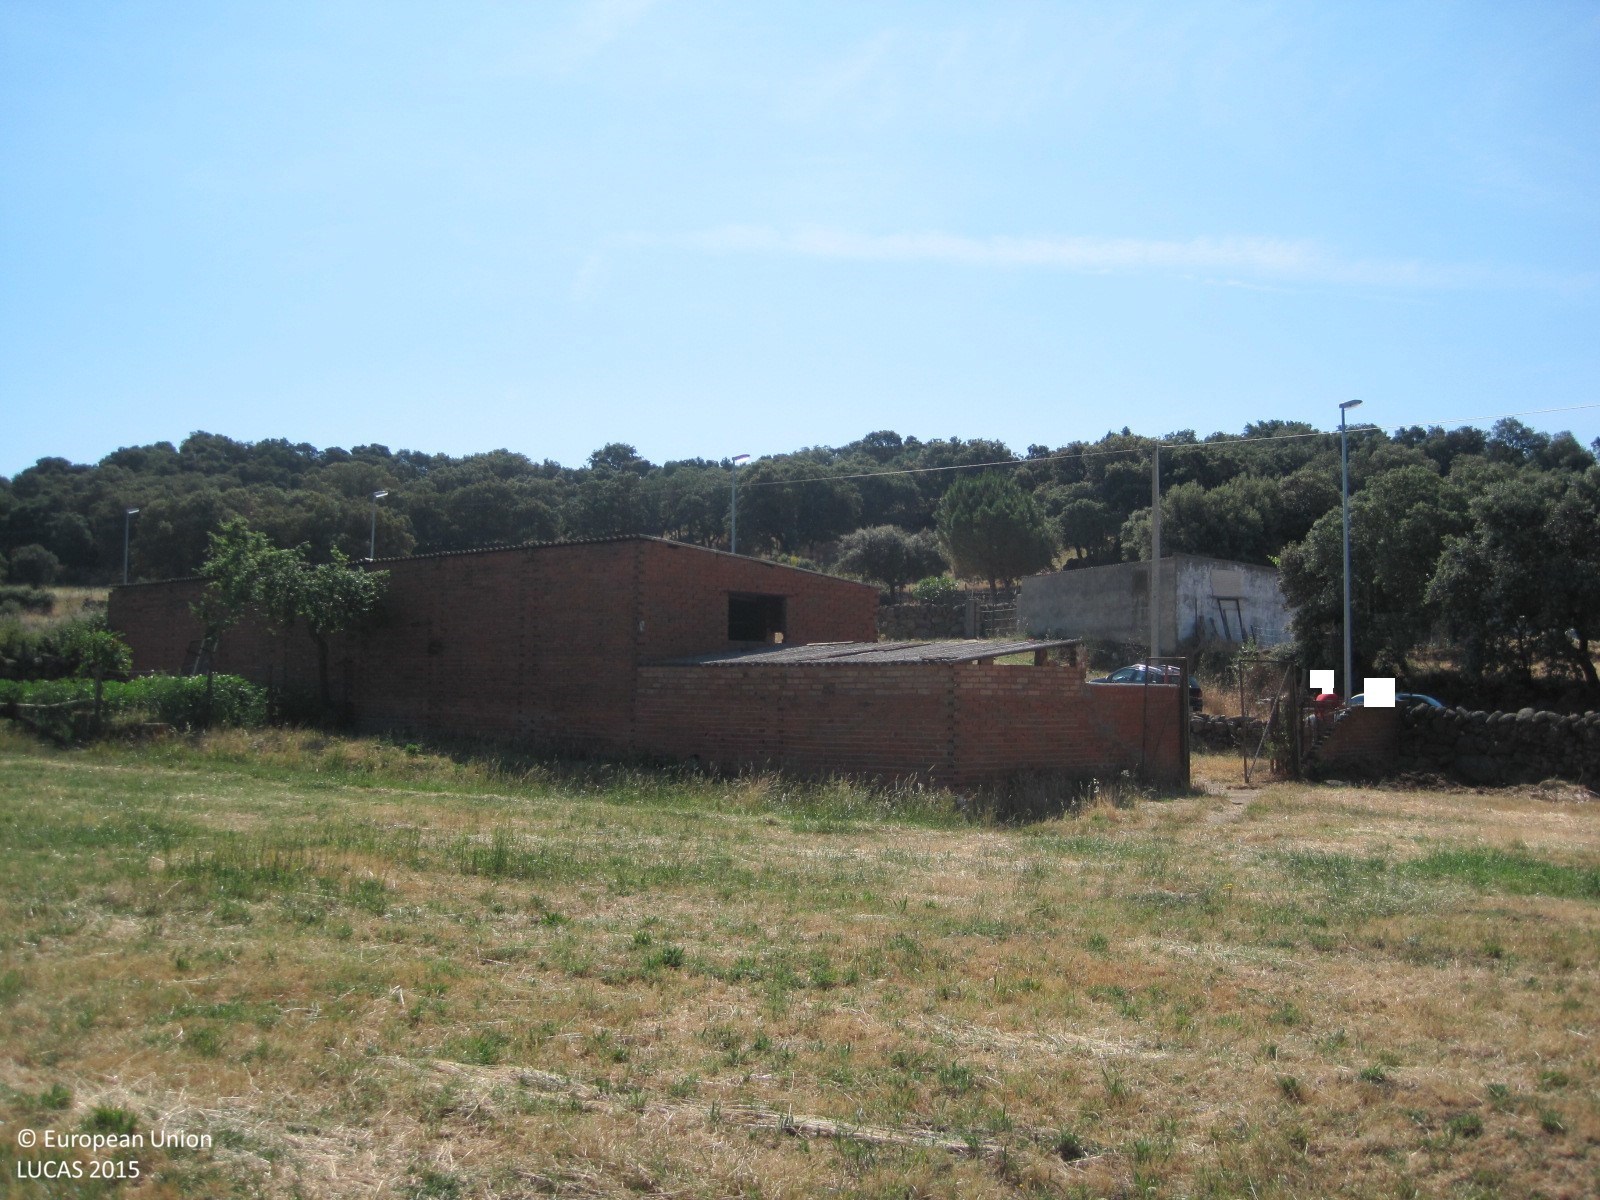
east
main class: Grassland
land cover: Grassland without tree/shrub cover
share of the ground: > 75 %
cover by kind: herbaceous plants 100 %
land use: Agriculture (excluding fallow land and kitchen gardens)
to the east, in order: Grassland without tree/shrub cover; Artificial constructions in urban areas; Grassland without tree/shrub cover; Grass margins; Dry stone walls; Paved roads, cycling and walking lanes; Grass margins; Grassland without tree/shrub cover; Fences; Grassland without tree/shrub cover; Fences; Grassland without tree/shrub cover; Tracks; Grass margins; Fences; Dry stone walls; Grassland with sparse tree/shrub cover; Fences; Dry stone walls; Broadleaved woodland
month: June
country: ES
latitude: 40.0547
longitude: -4.8076
